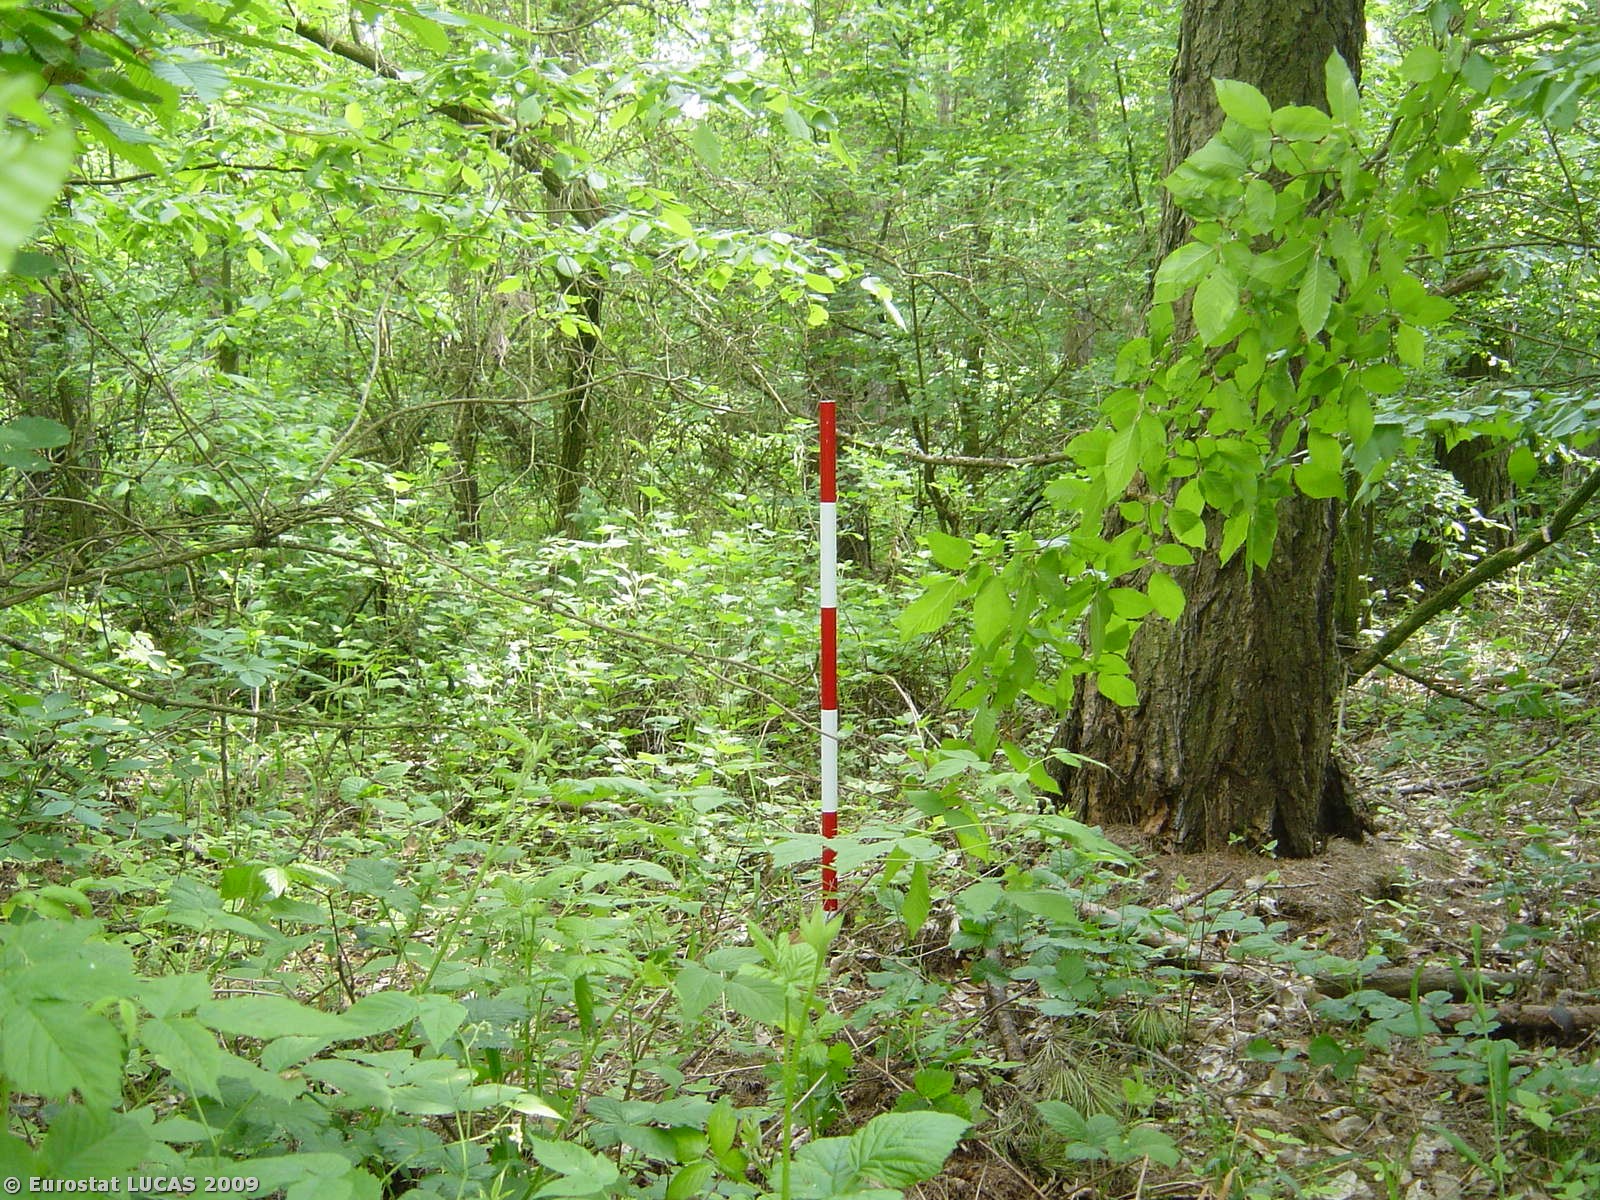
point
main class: Woodland
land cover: Mixed woodland
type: hemiboreal forest and nemoral coniferous forest and mixed broadleaved-coniferous forest
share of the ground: > 75 %
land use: Forestry
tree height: > 5 m
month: May
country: CZ
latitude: 49.1185
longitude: 16.4326
